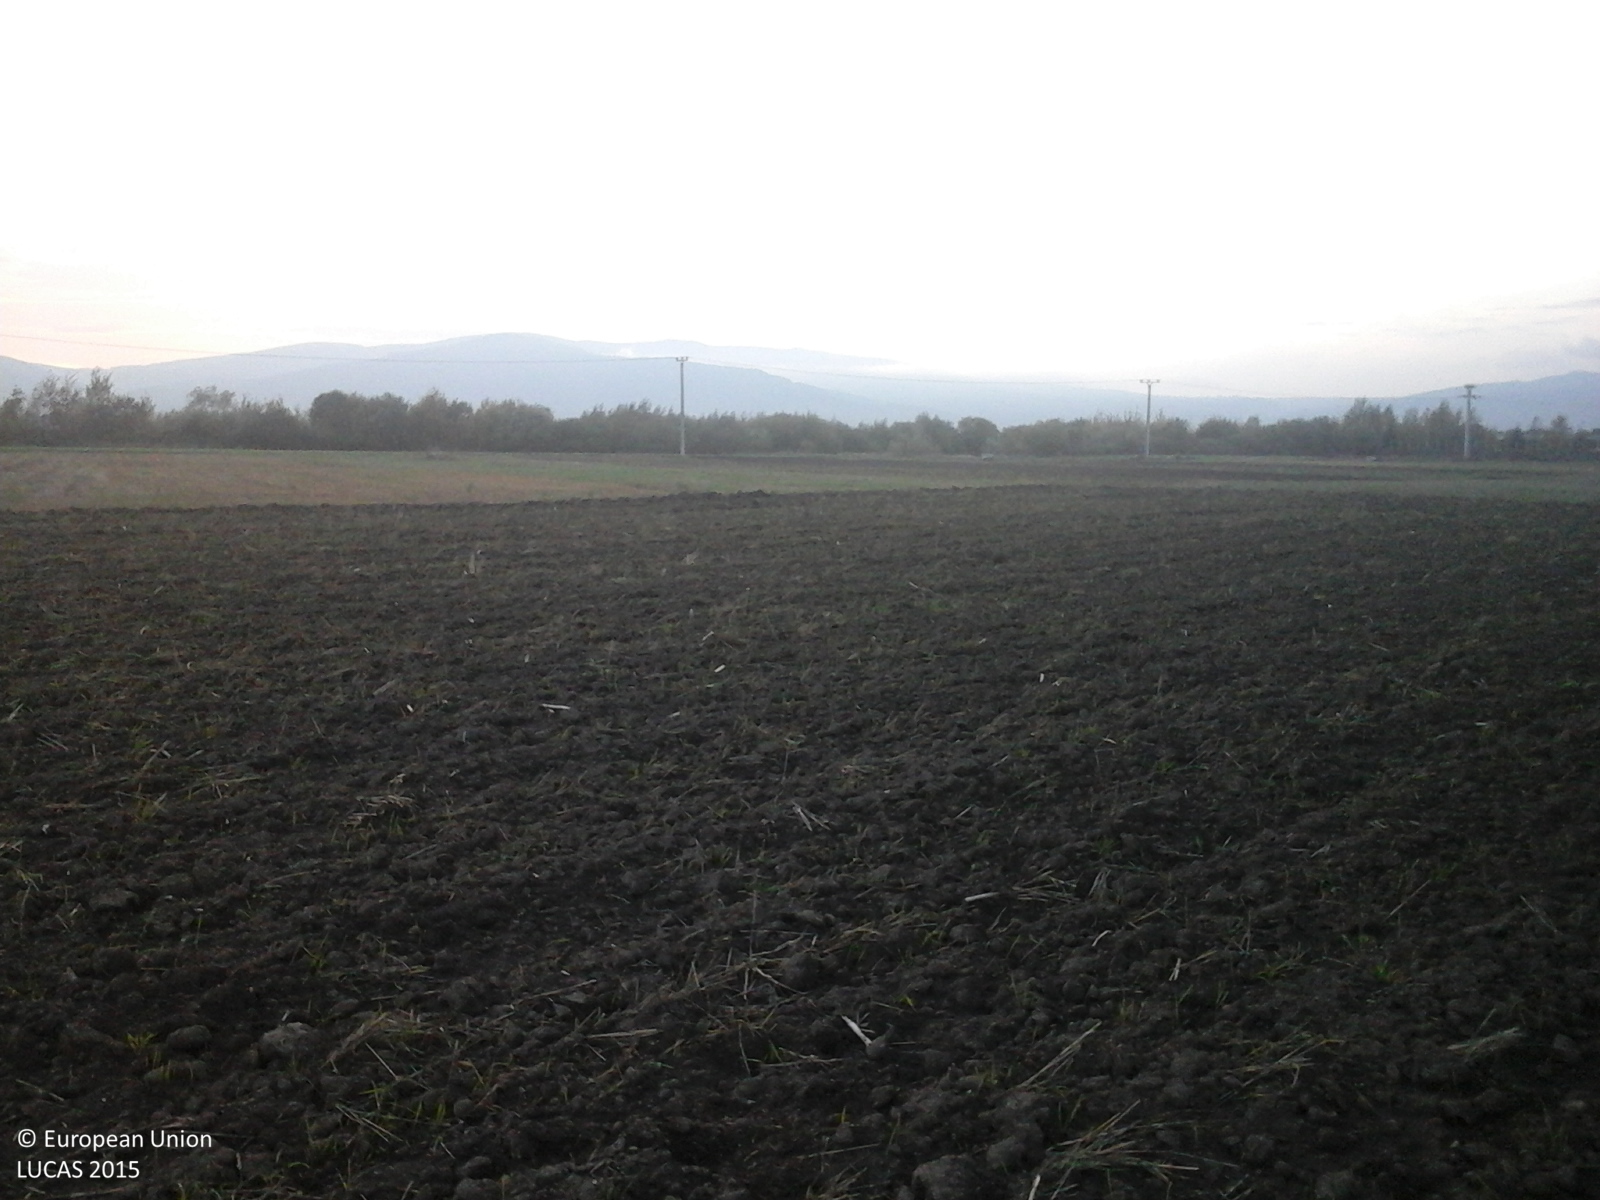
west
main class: Cropland
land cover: Common wheat
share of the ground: < 10 %
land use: Agriculture (excluding fallow land and kitchen gardens)
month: October
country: RO
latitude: 46.7005
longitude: 25.4768
